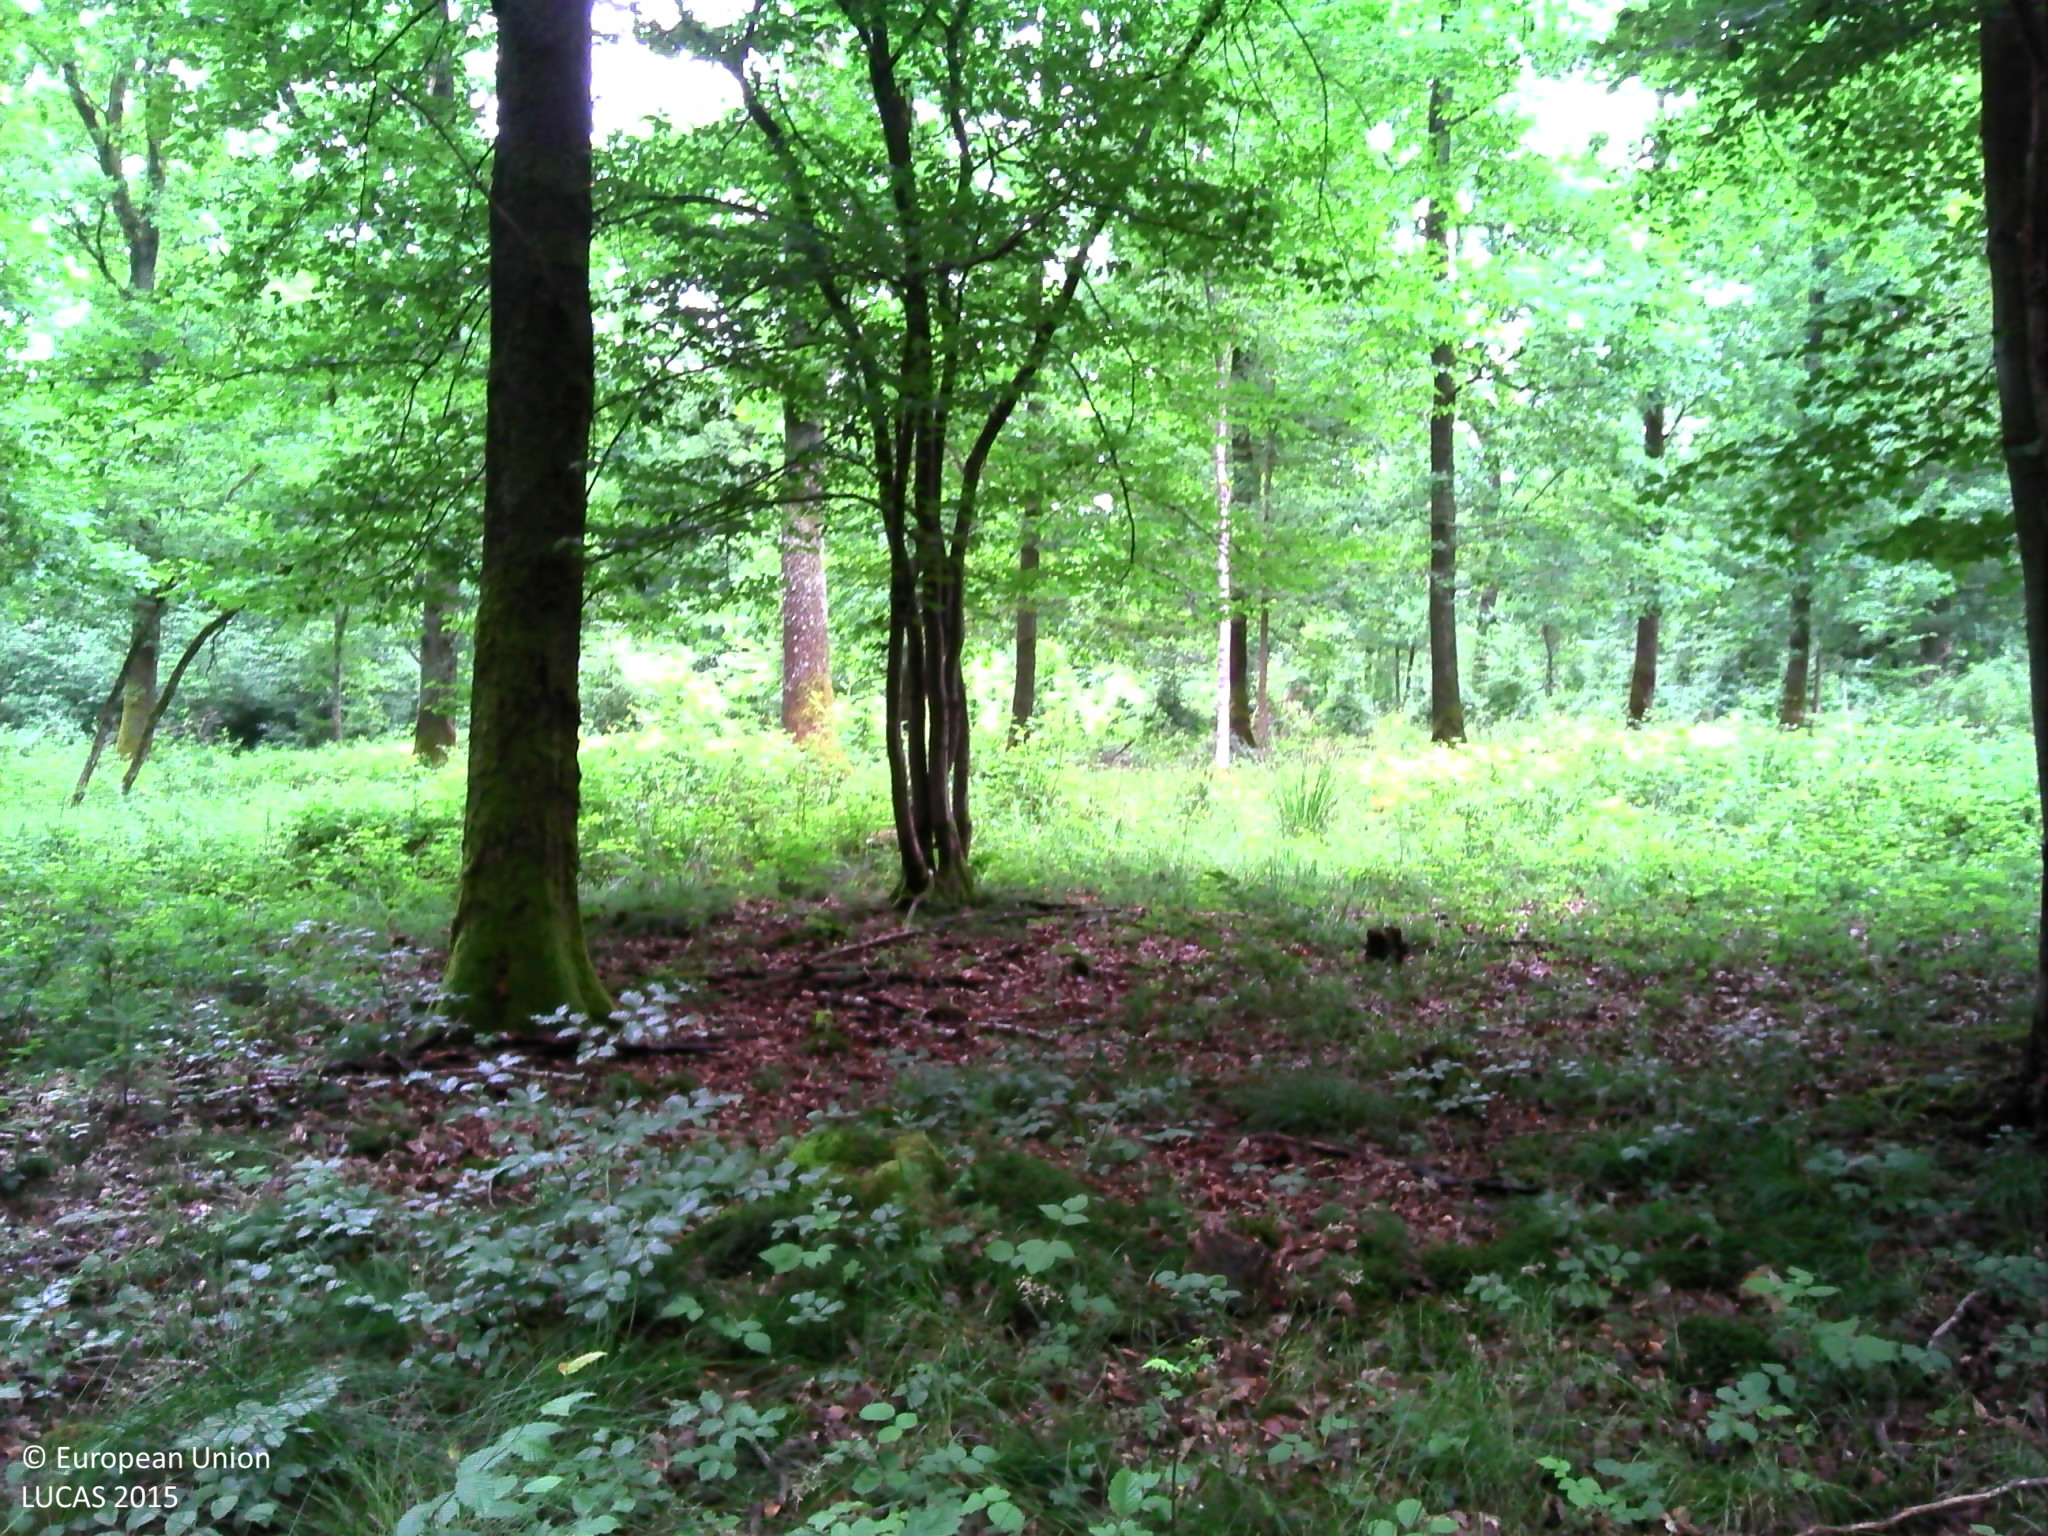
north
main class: Woodland
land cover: Broadleaved woodland
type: acidophilous oak and oak-birch forest
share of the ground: > 75 %
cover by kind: broadleaved forest trees 85 %, coniferous forest trees 5 %, herbaceous plants 5 %, lichens and mosses 5 %
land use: Forestry
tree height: > 5 m
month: June
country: BE
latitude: 50.3335
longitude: 5.6011
